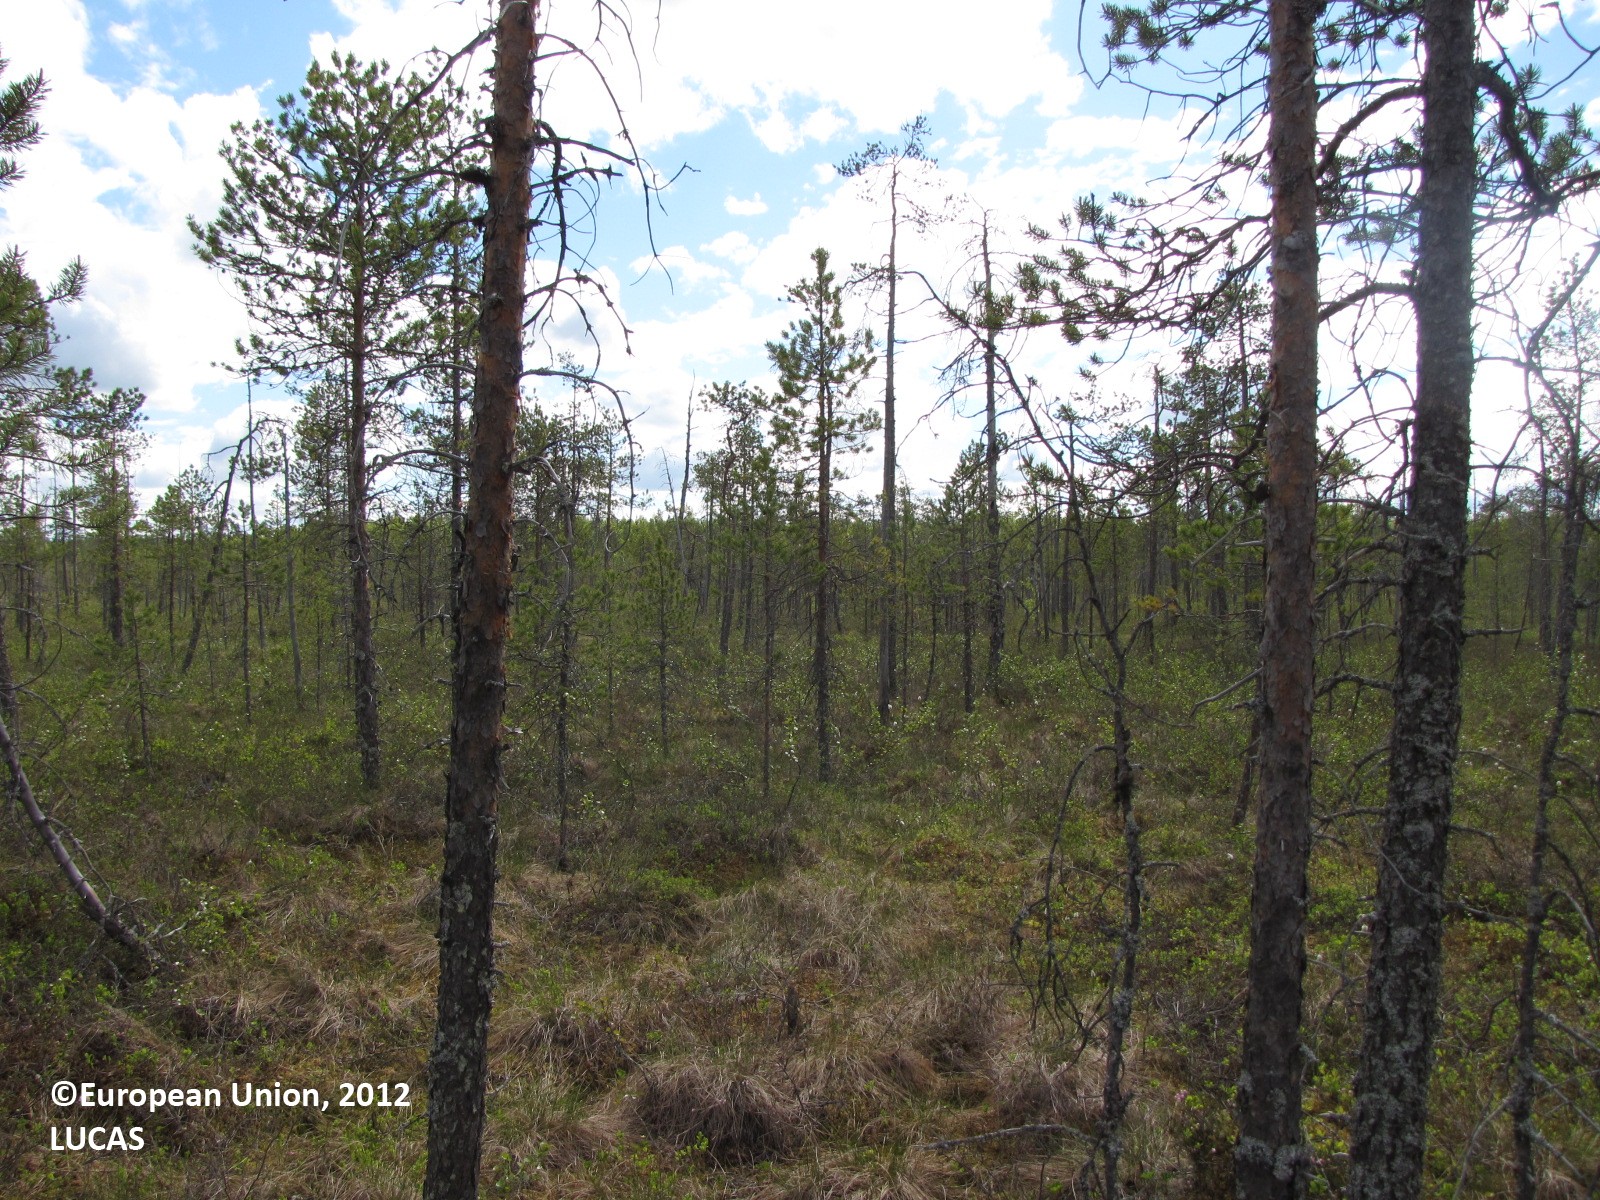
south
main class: Woodland
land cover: Pine dominated coniferous woodland
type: boreal forest
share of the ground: 10 - 25 %
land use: Forestry
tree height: > 5 m
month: June
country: FI
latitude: 66.0991
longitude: 25.2151
